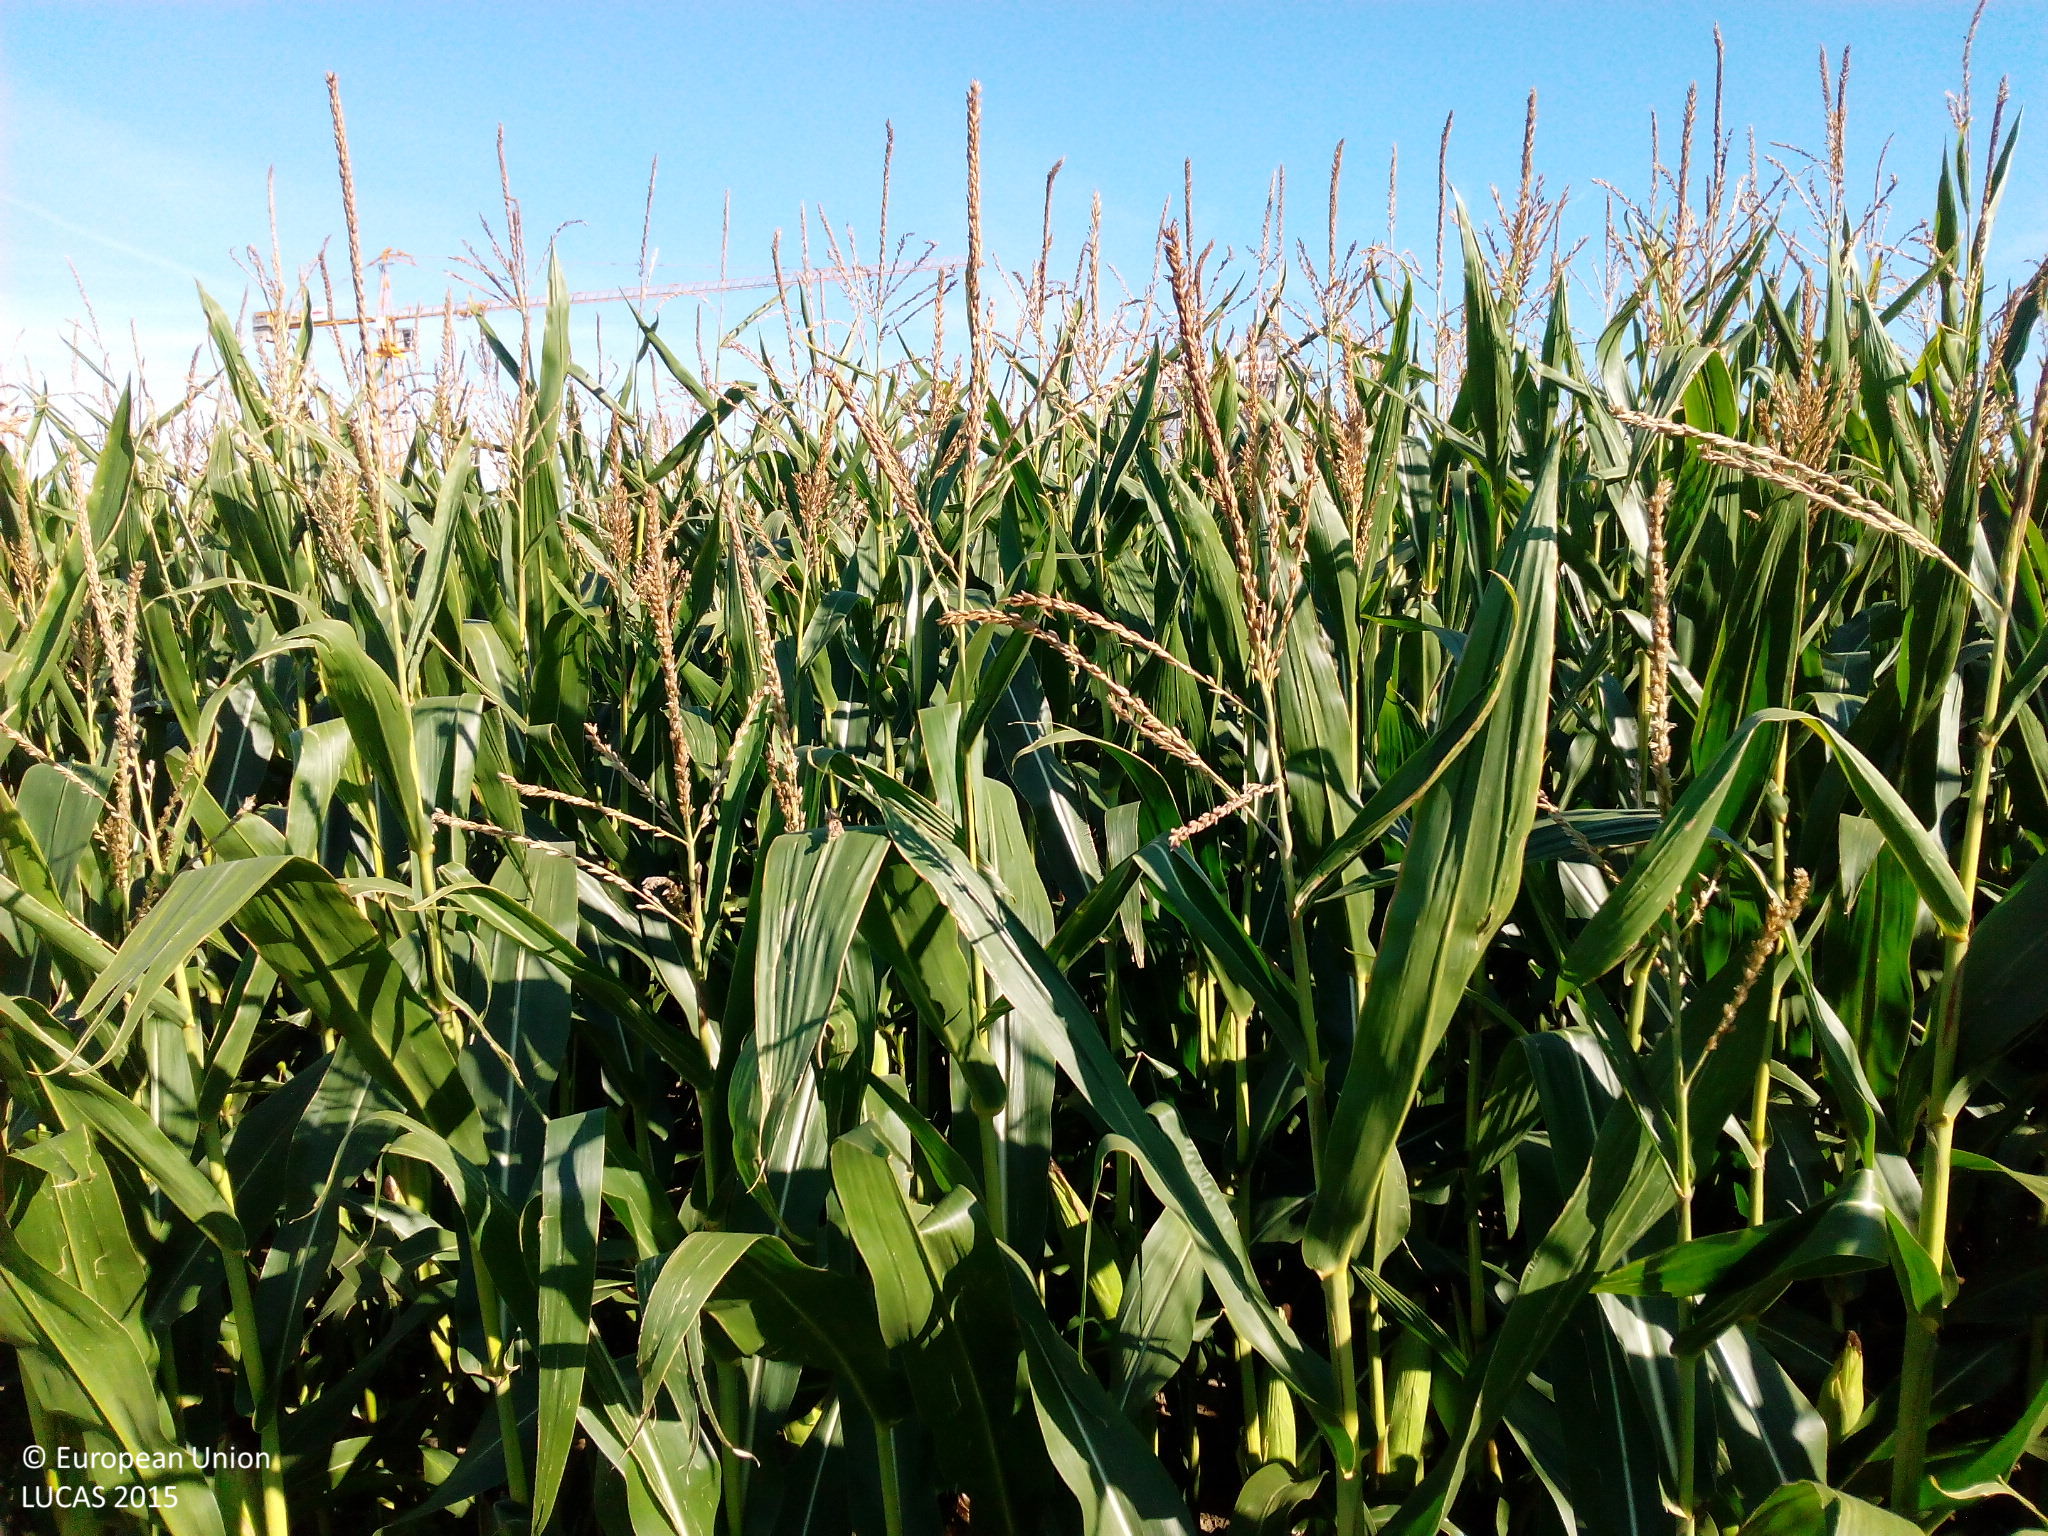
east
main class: Cropland
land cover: Maize
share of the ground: > 75 %
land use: Agriculture (excluding fallow land and kitchen gardens)
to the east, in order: Maize; Grass margins; Artificial constructions in urban areas
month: August
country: DE
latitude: 48.3315
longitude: 9.9596
